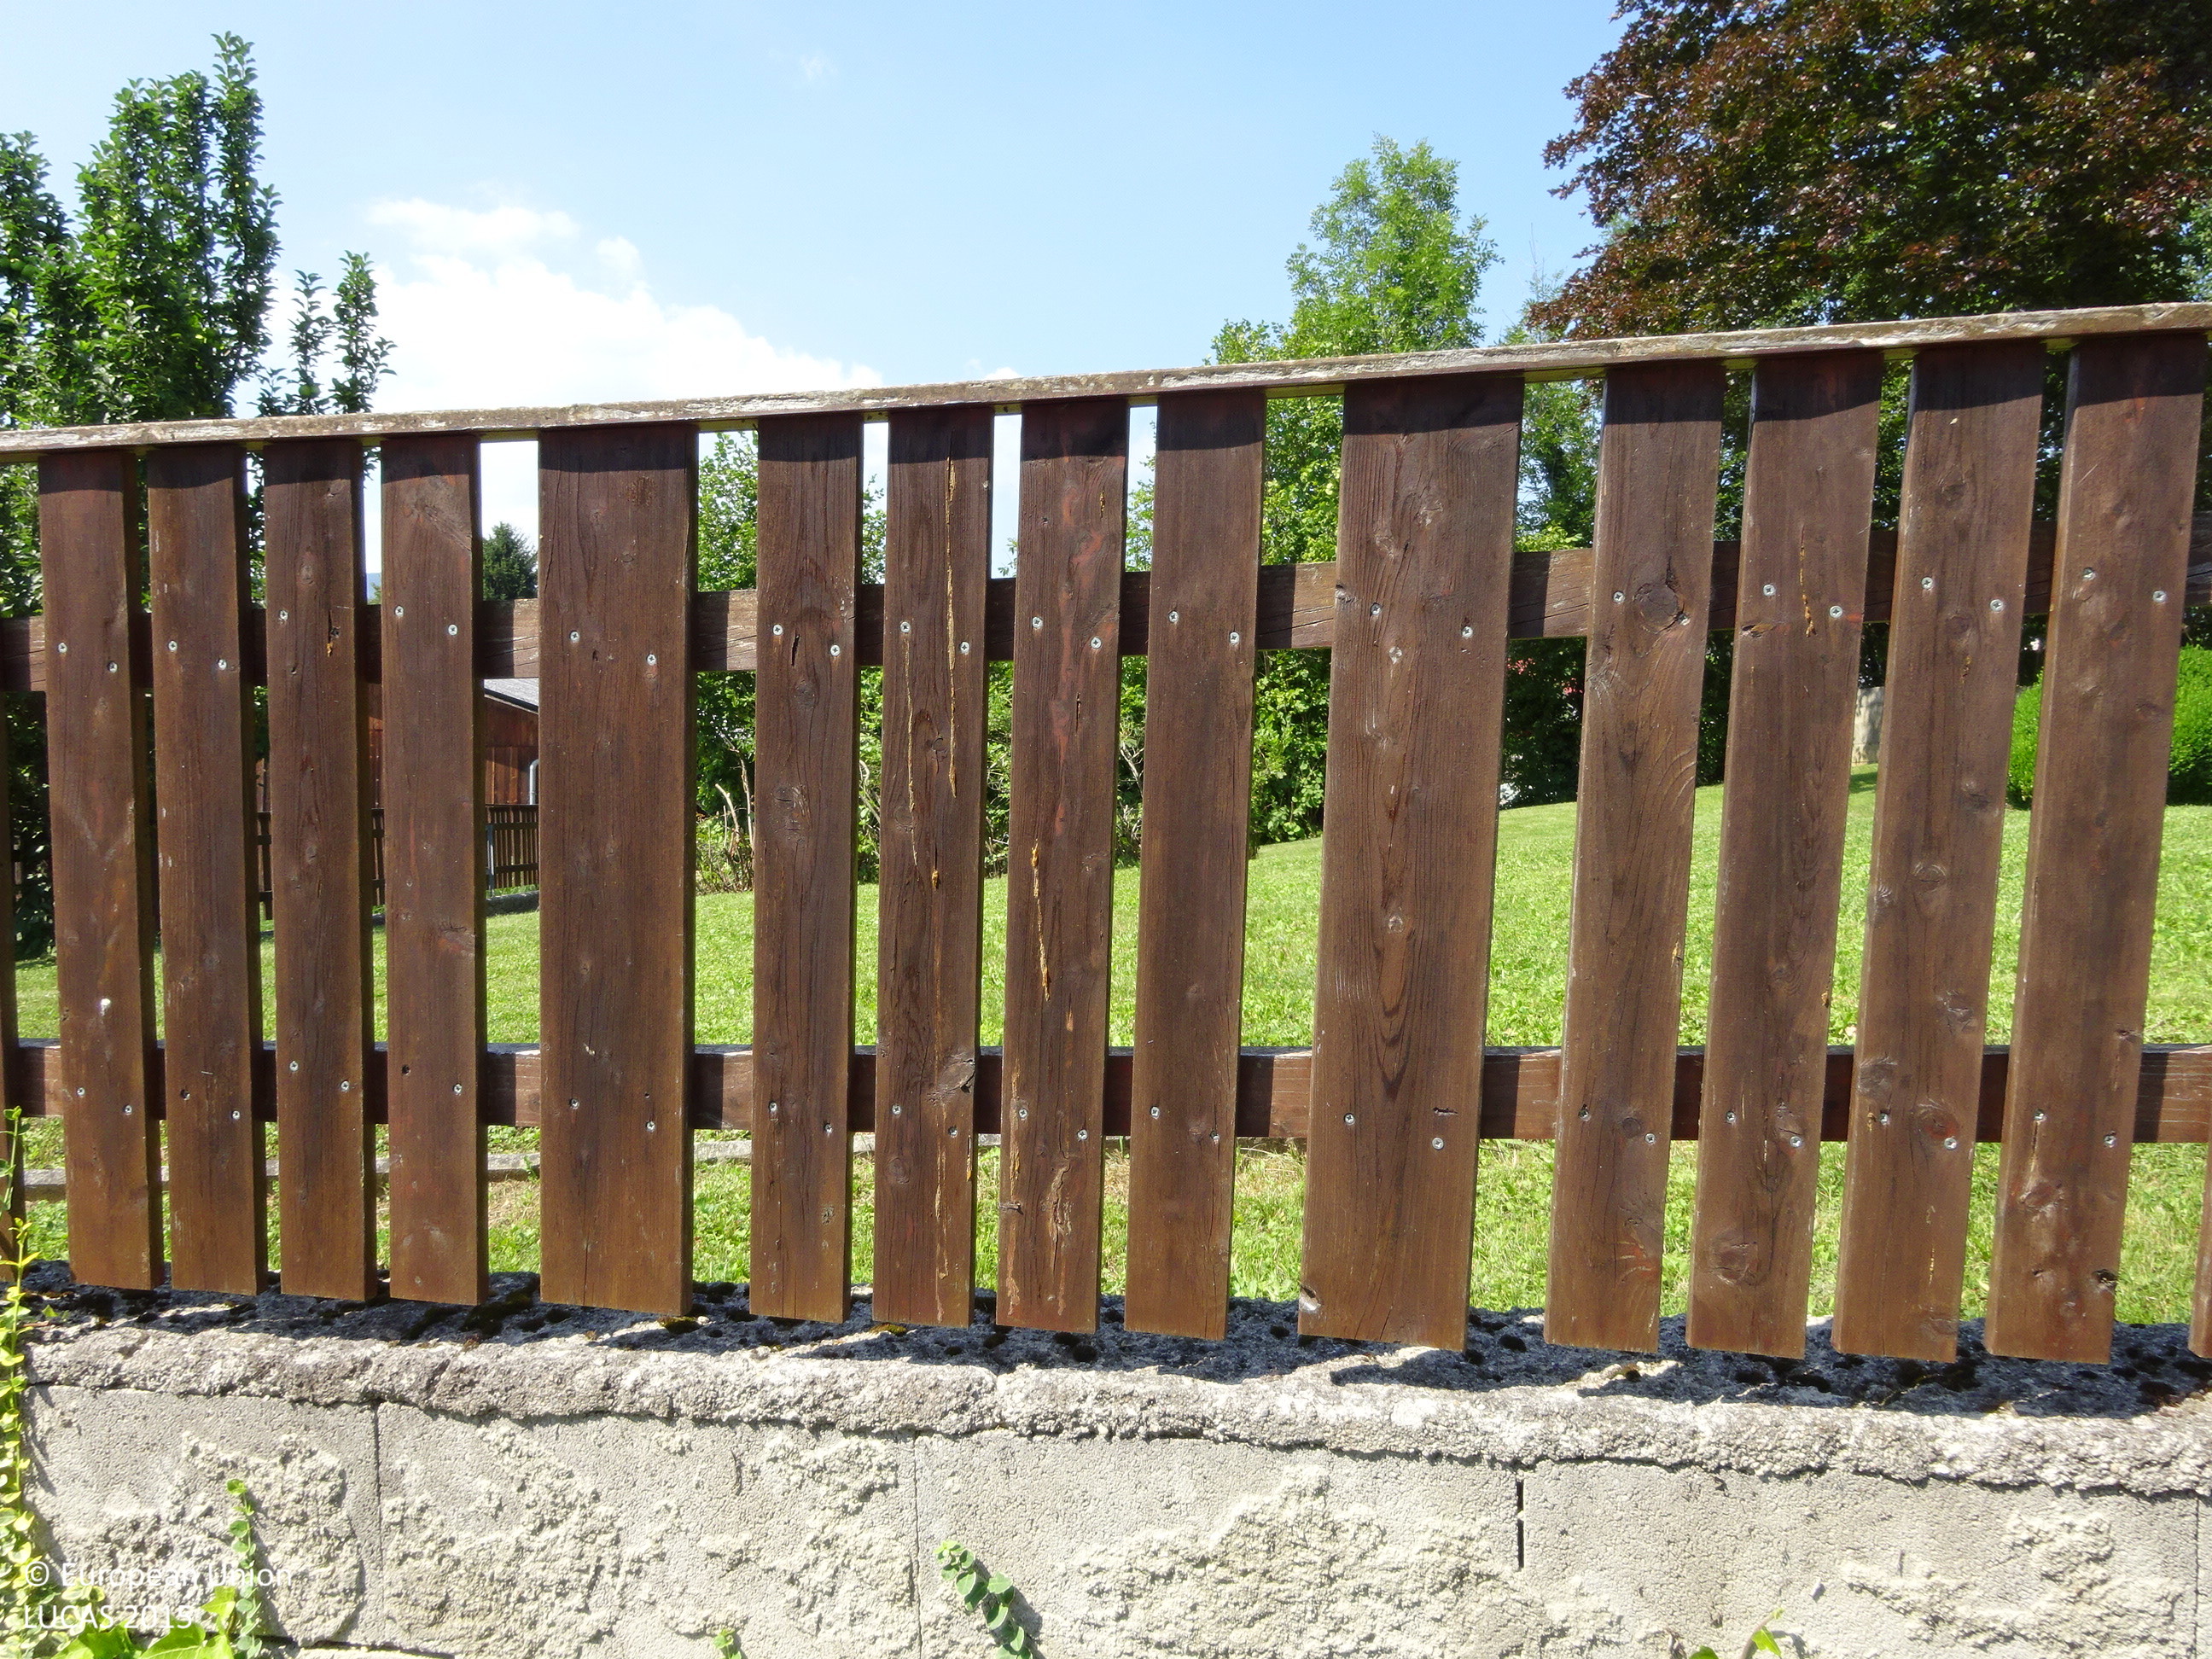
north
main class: Grassland
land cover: Grassland with sparse tree/shrub cover
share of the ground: 25 - 50 %
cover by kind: herbaceous plants 55 %, consolidated bare surface 40 %, broadleaved forest trees 5 %
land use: Residential
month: August
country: AT
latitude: 47.4266
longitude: 16.0340
